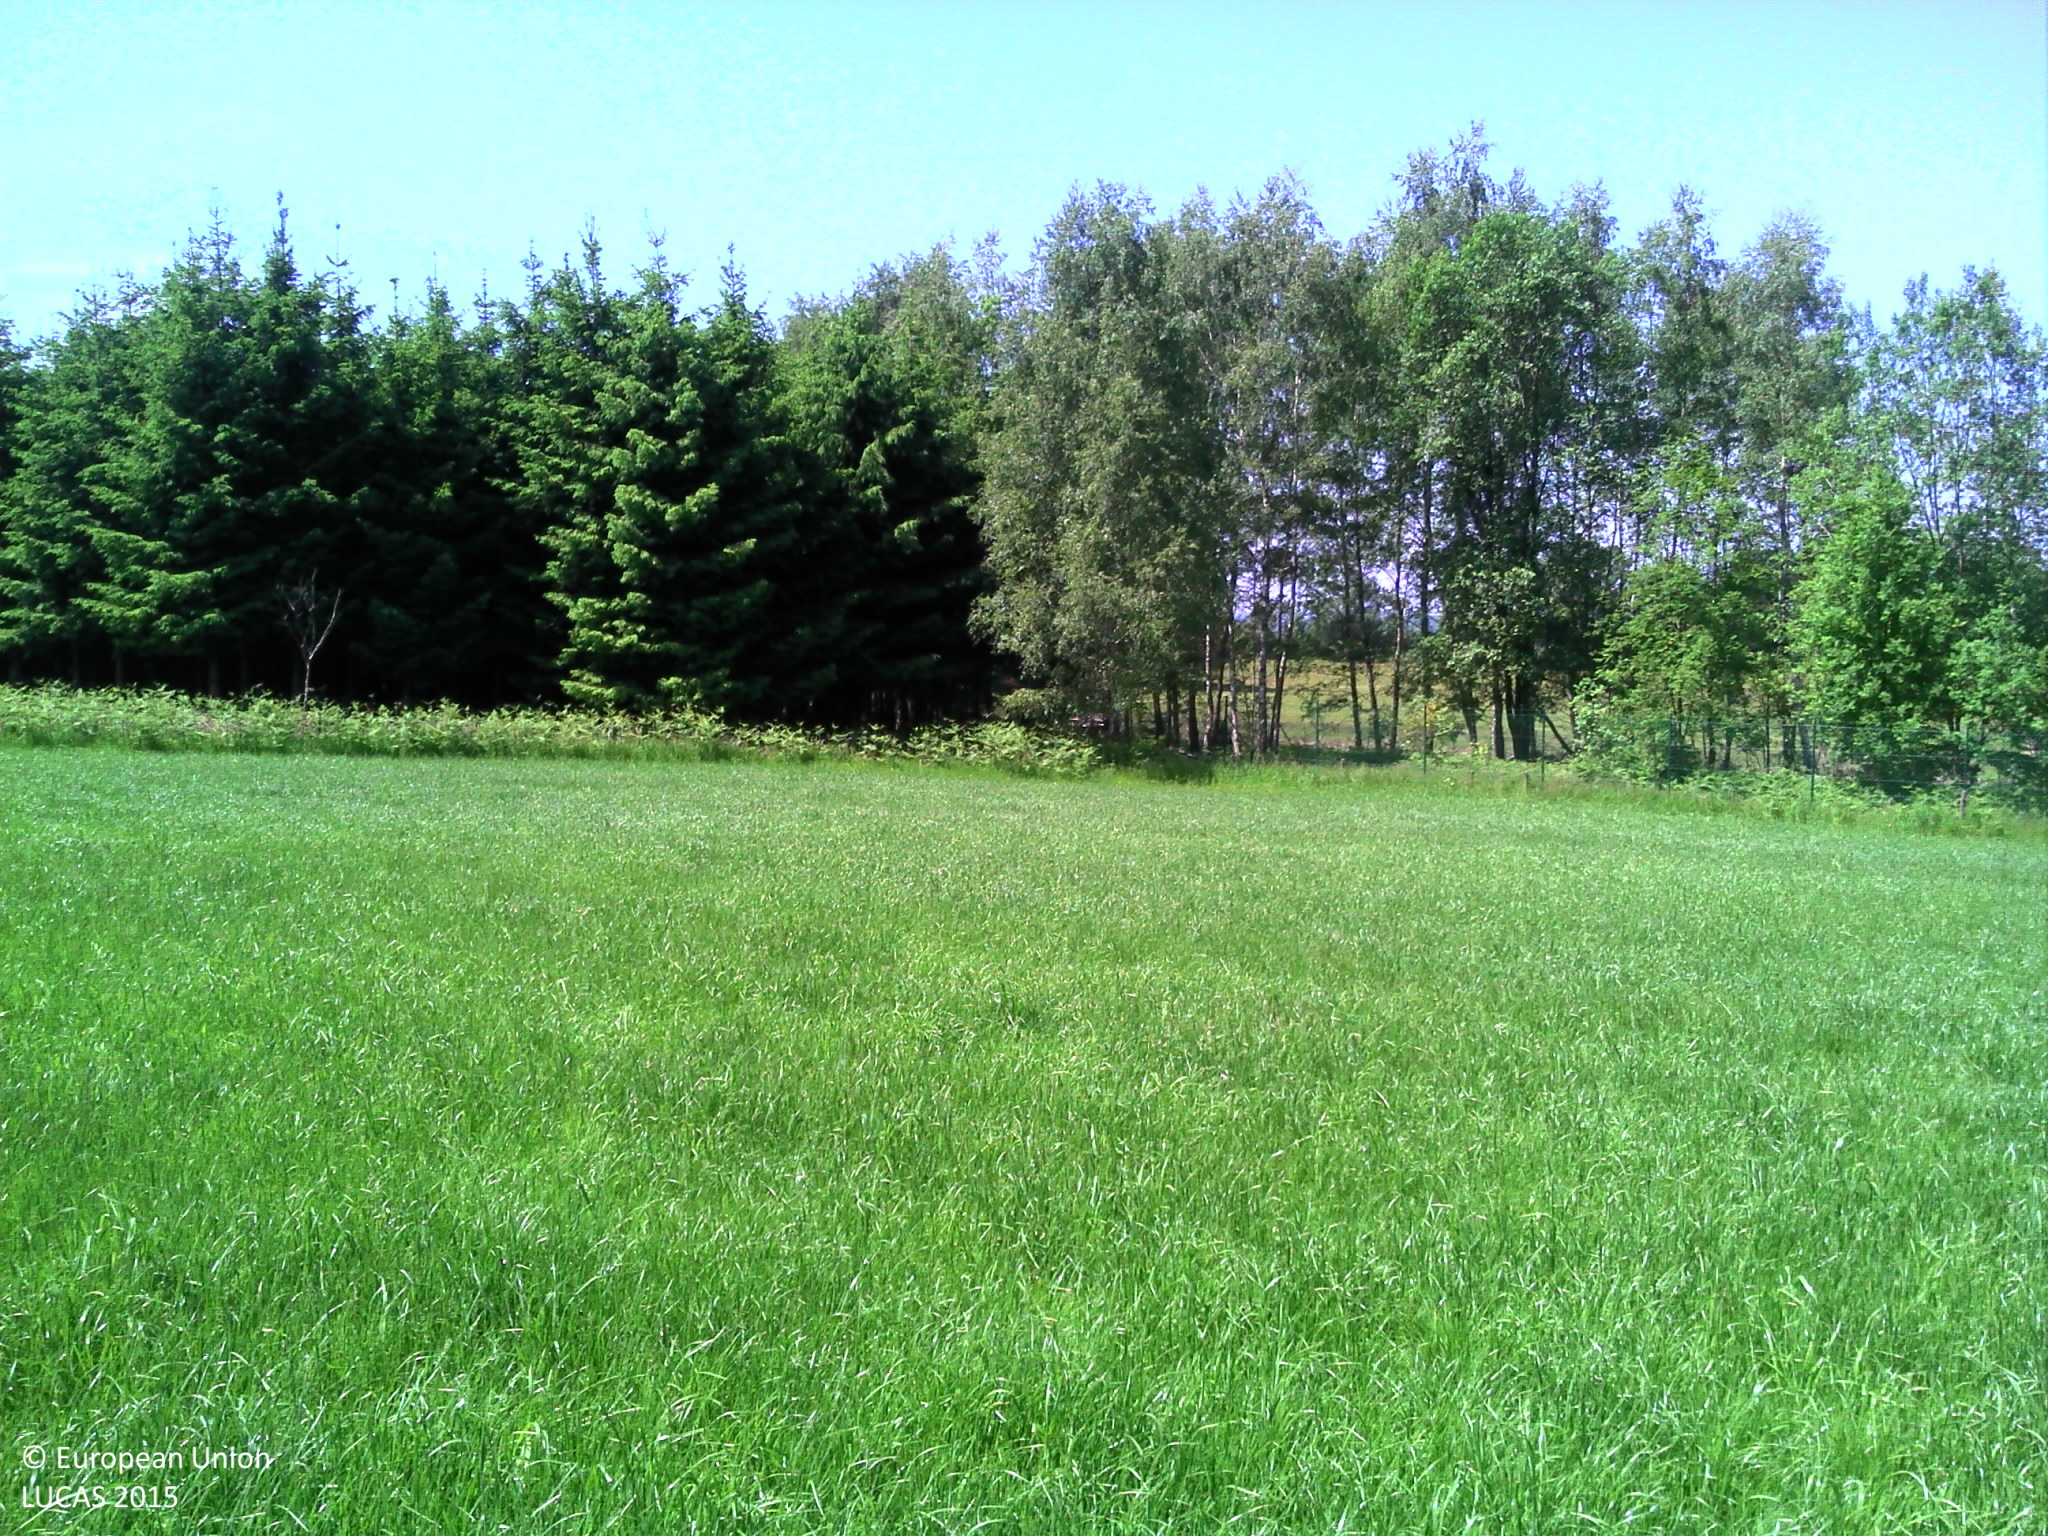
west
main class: Grassland
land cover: Grassland without tree/shrub cover
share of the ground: > 75 %
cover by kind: herbaceous plants 100 %
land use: Agriculture (excluding fallow land and kitchen gardens)
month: June
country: BE
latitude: 50.4834
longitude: 5.7565
